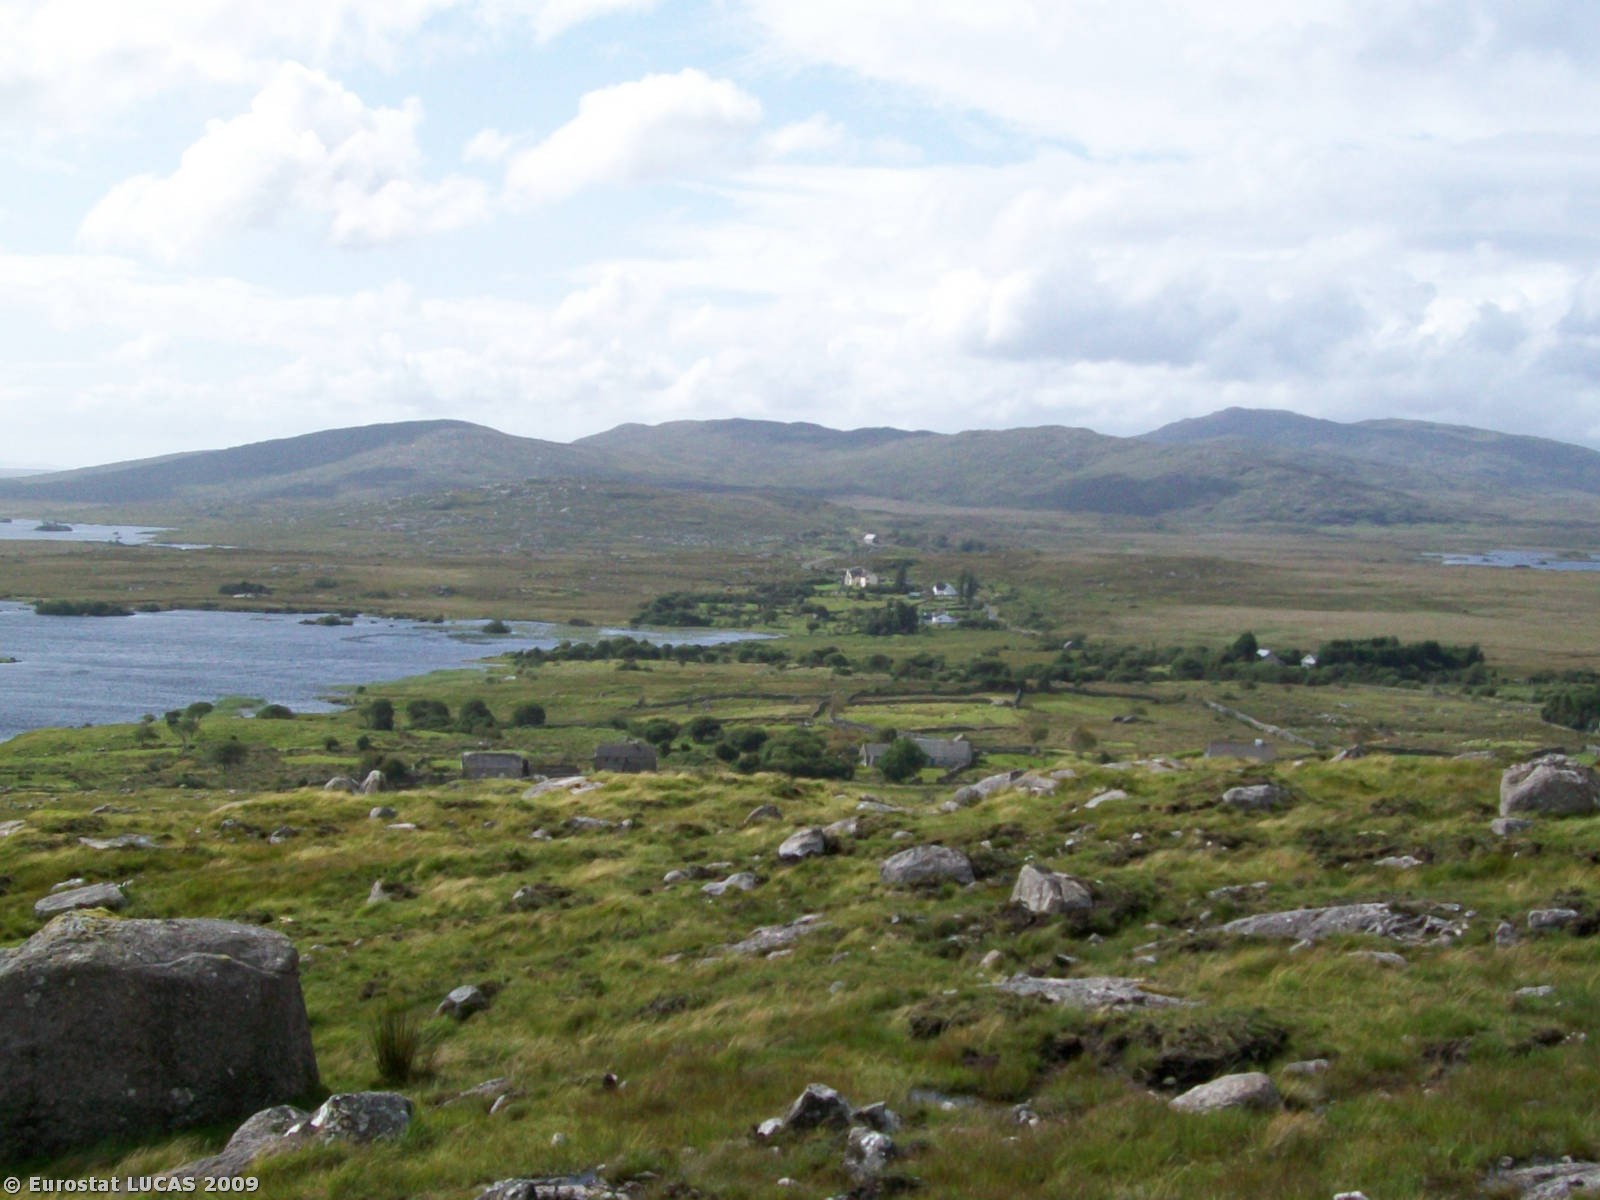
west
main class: Grassland
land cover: Grassland without tree/shrub cover
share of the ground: > 75 %
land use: Nature reserves
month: August
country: IE
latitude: 53.3884
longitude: -9.4935
